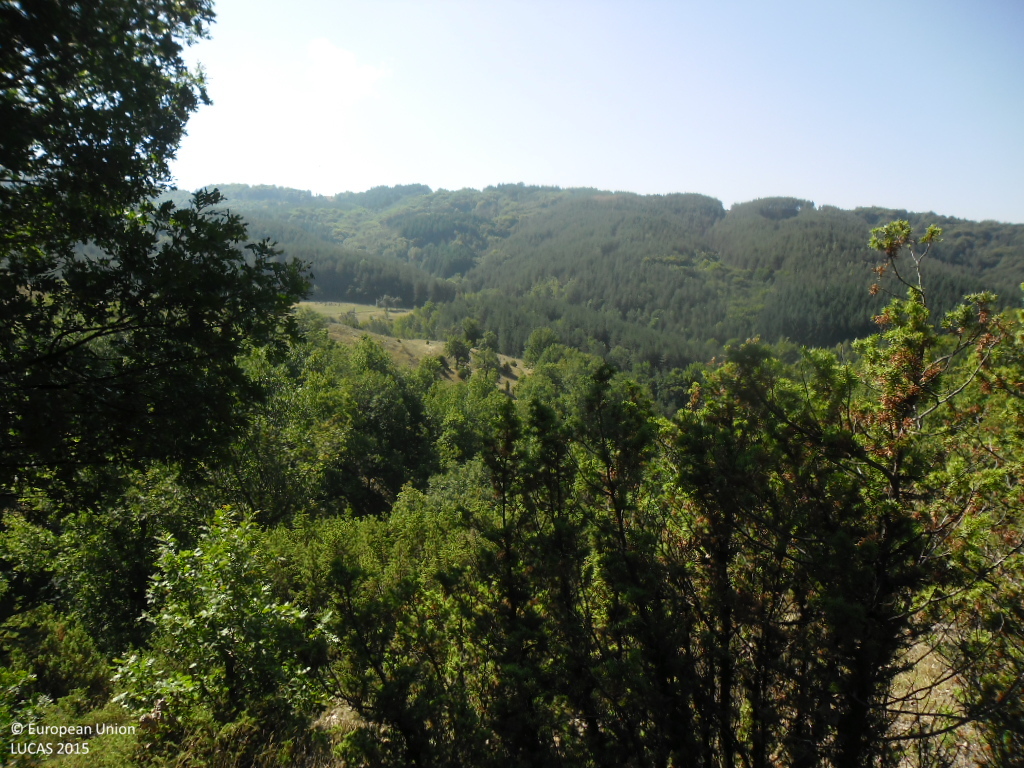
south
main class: Woodland
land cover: Other mixed woodland
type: hemiboreal forest and nemoral coniferous forest and mixed broadleaved-coniferous forest
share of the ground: > 75 %
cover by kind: coniferous forest trees 60 %, broadleaved forest trees 40 %
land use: Forestry
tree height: < 5 m
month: September
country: BG
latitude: 42.0055
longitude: 23.1980
